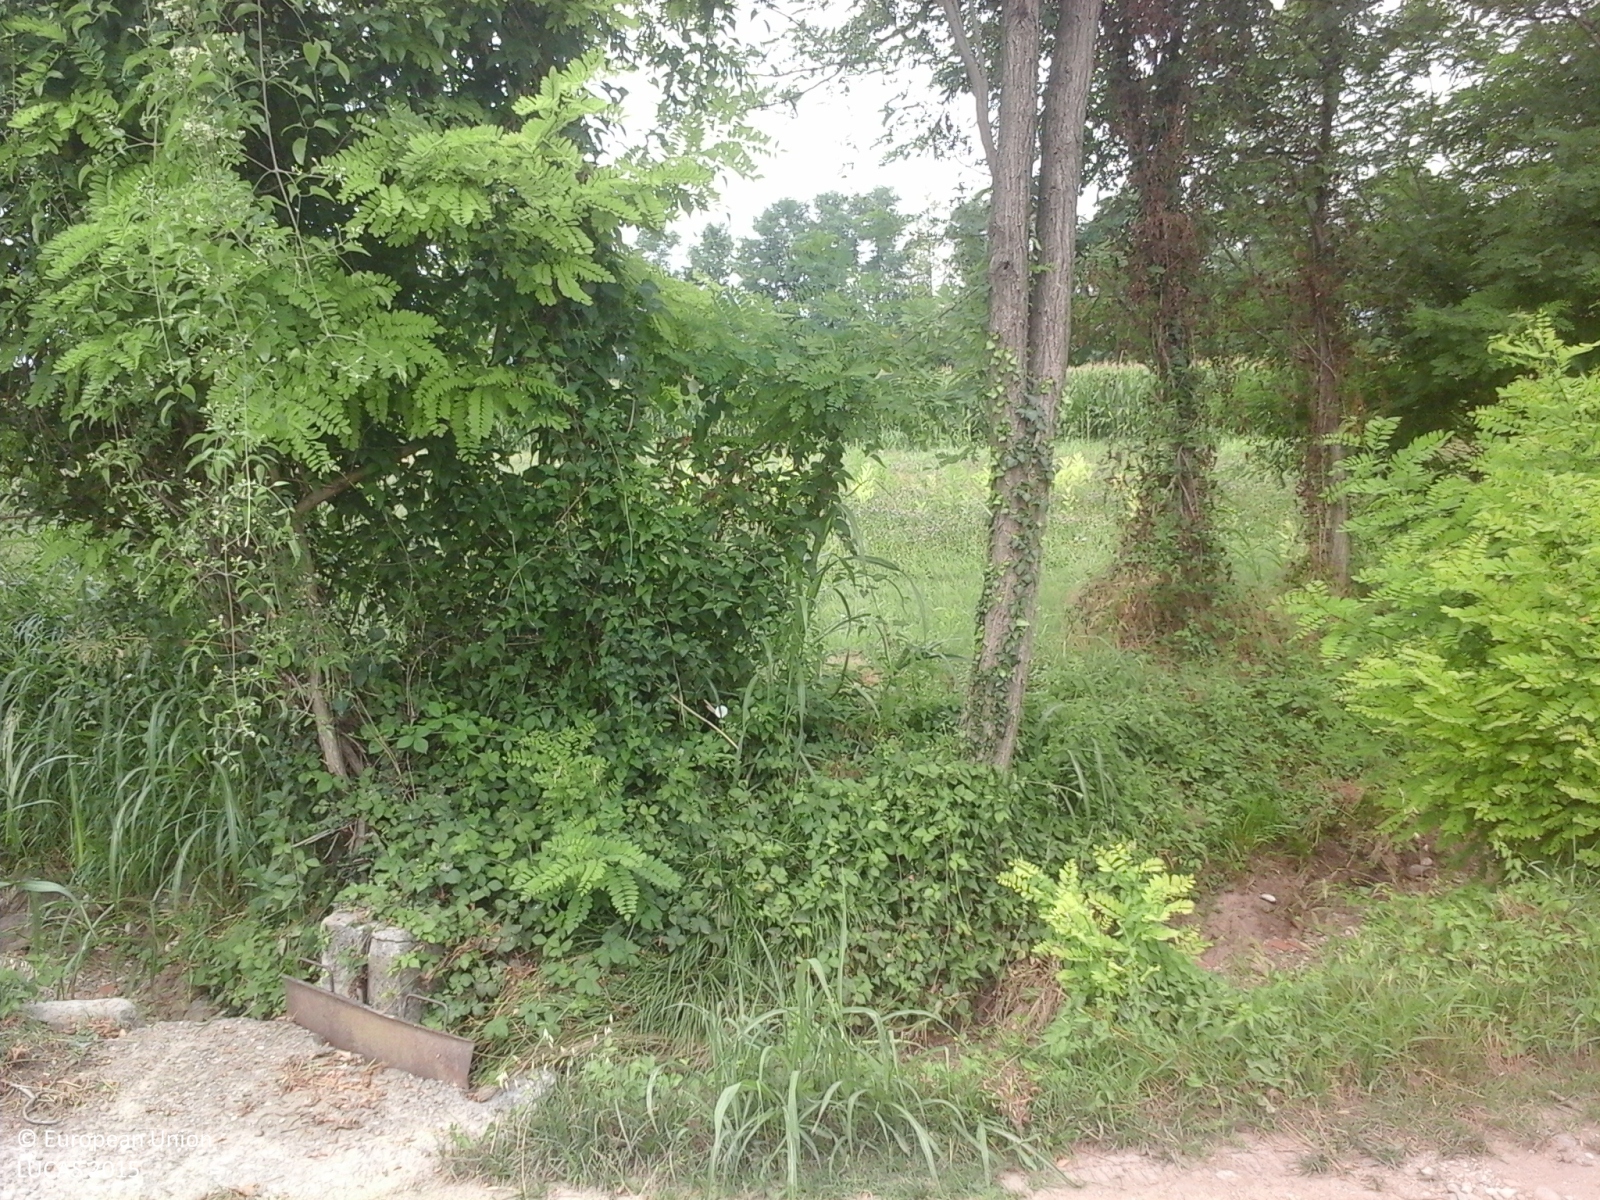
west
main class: Cropland
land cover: Maize
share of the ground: > 75 %
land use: Agriculture (excluding fallow land and kitchen gardens)
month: July
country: IT
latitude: 45.5396
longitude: 10.4219
